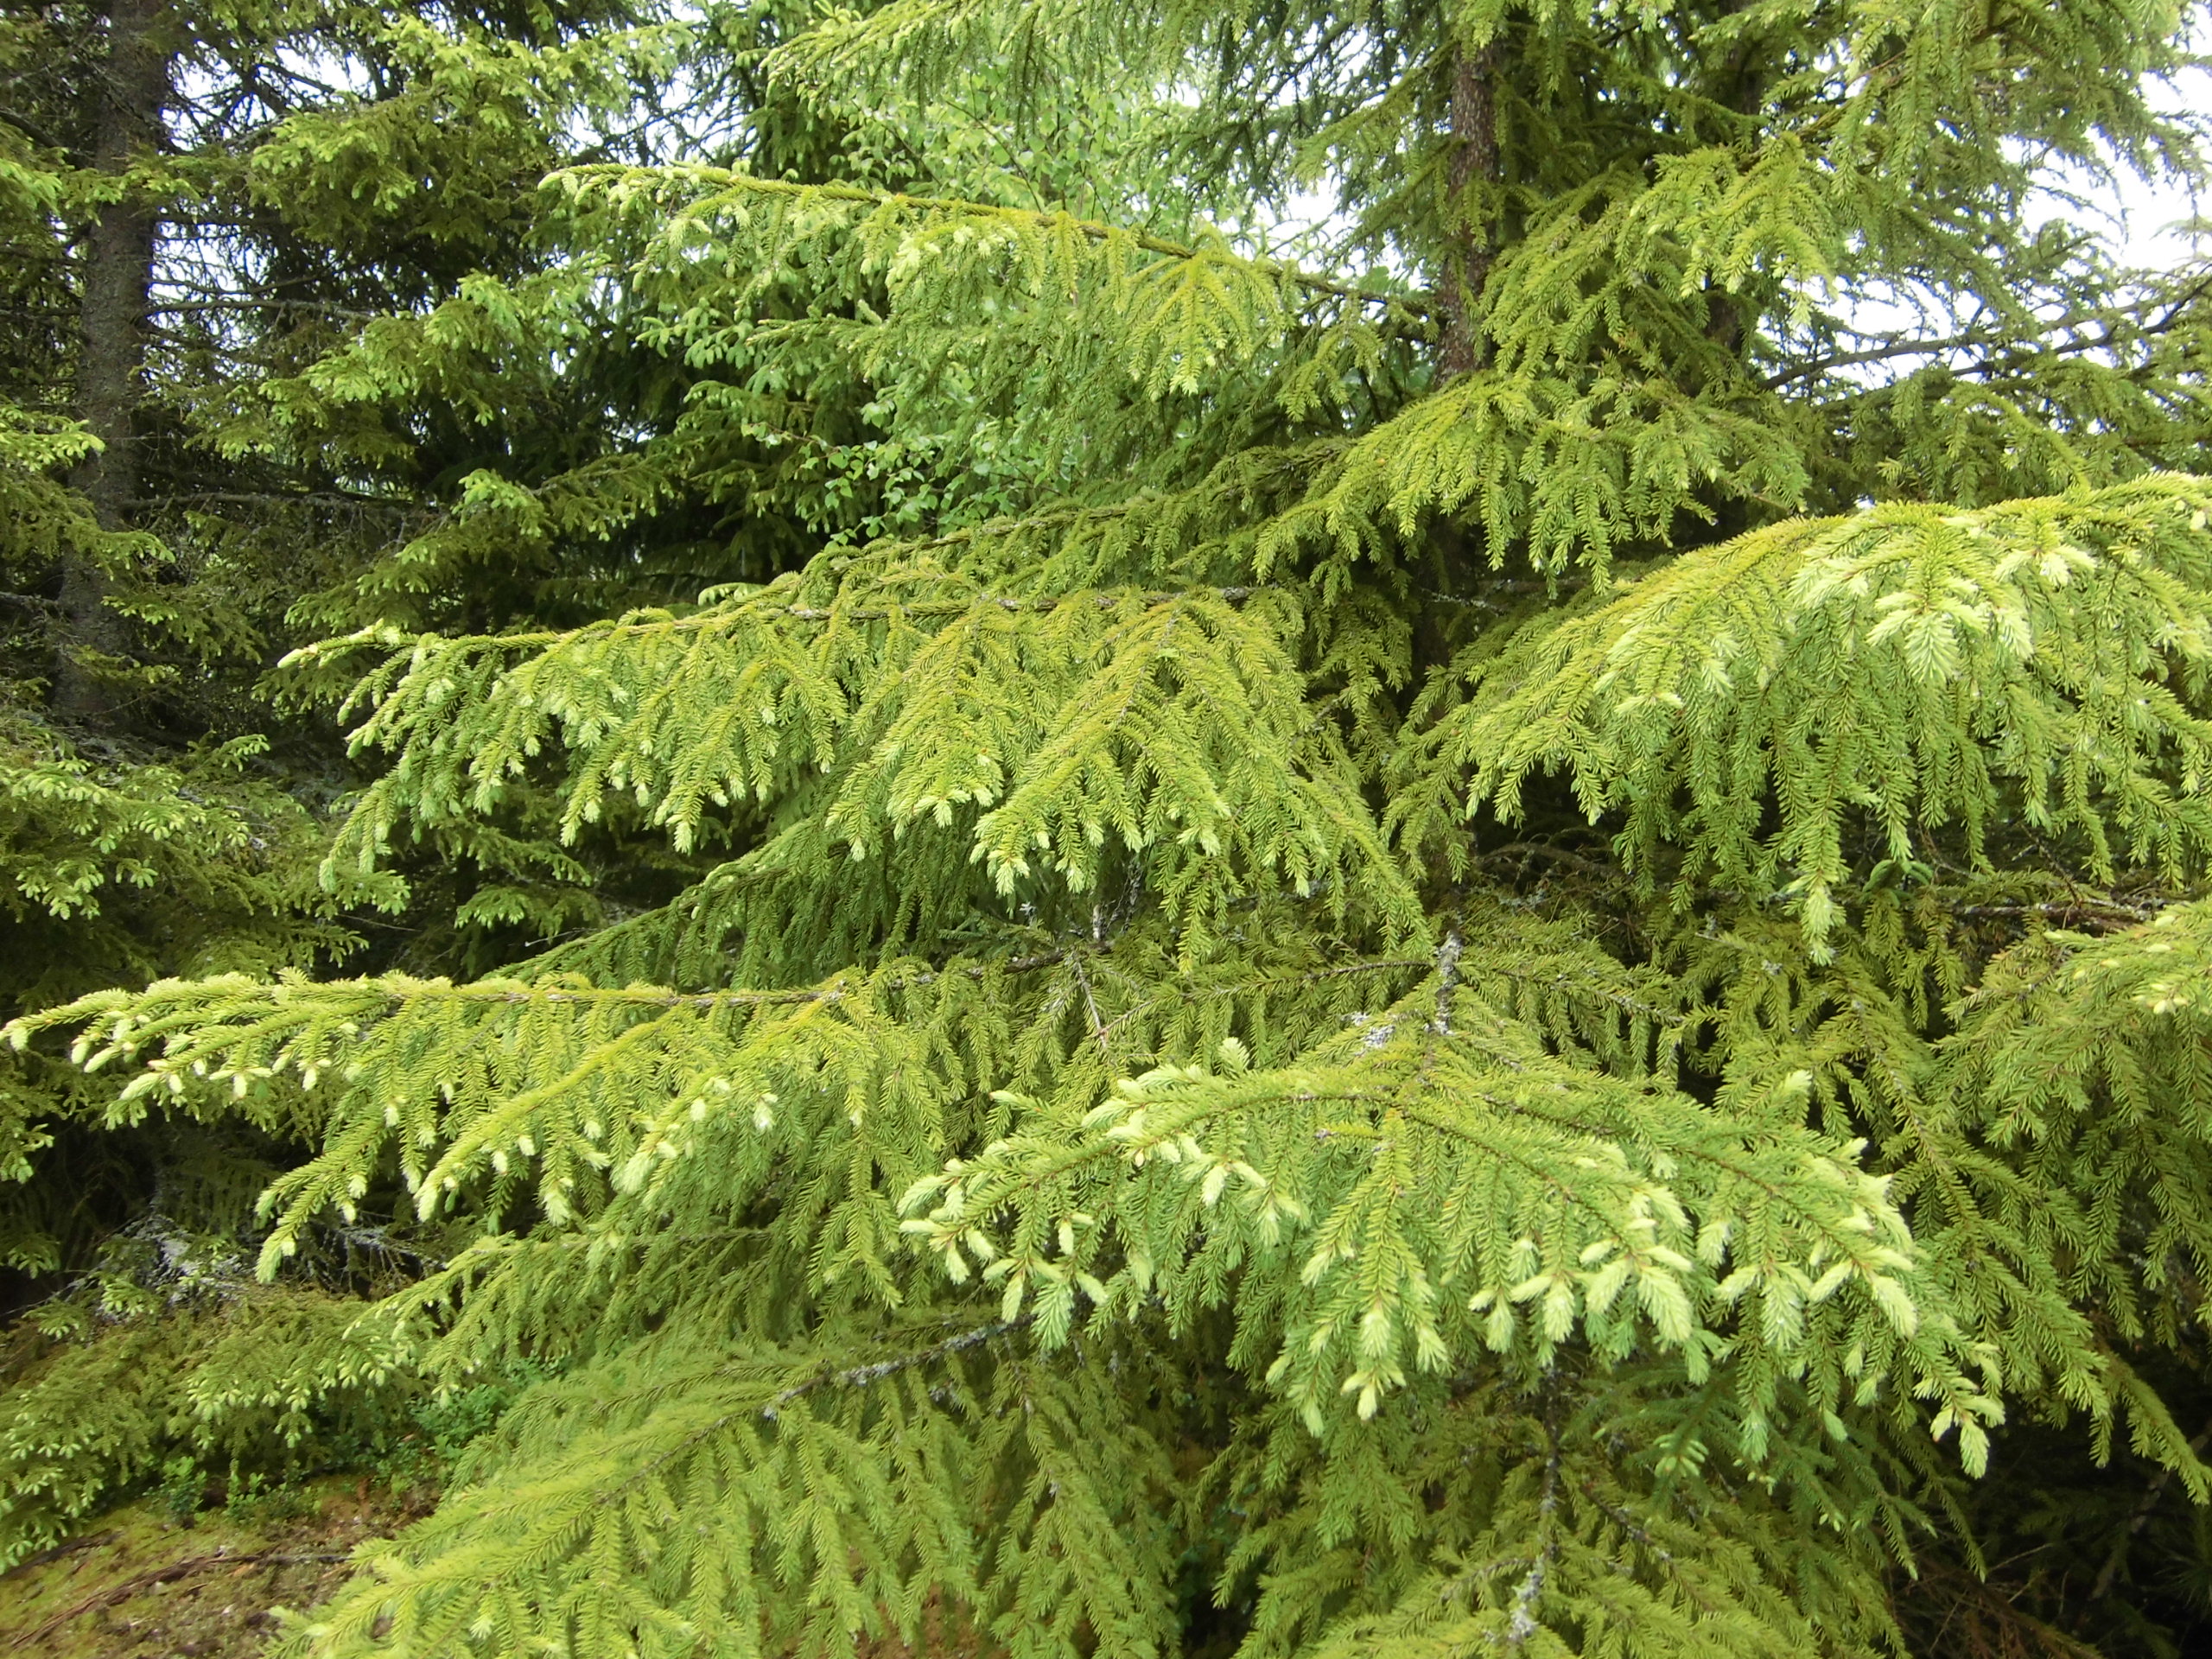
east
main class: Woodland
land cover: Spruce dominated mixed woodland
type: boreal forest
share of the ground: 50 - 75 %
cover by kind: coniferous forest trees 30 %, broadleaved forest trees 30 %, lichens and mosses 20 %, shrubs 10 %, herbaceous plants 10 %
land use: Forestry
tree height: > 5 m
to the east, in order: Spruce dominated mixed woodland; Spruce dominated coniferous woodland; Spruce dominated mixed woodland; Spruce dominated coniferous woodland
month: June
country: SE
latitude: 57.0597
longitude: 15.0923
